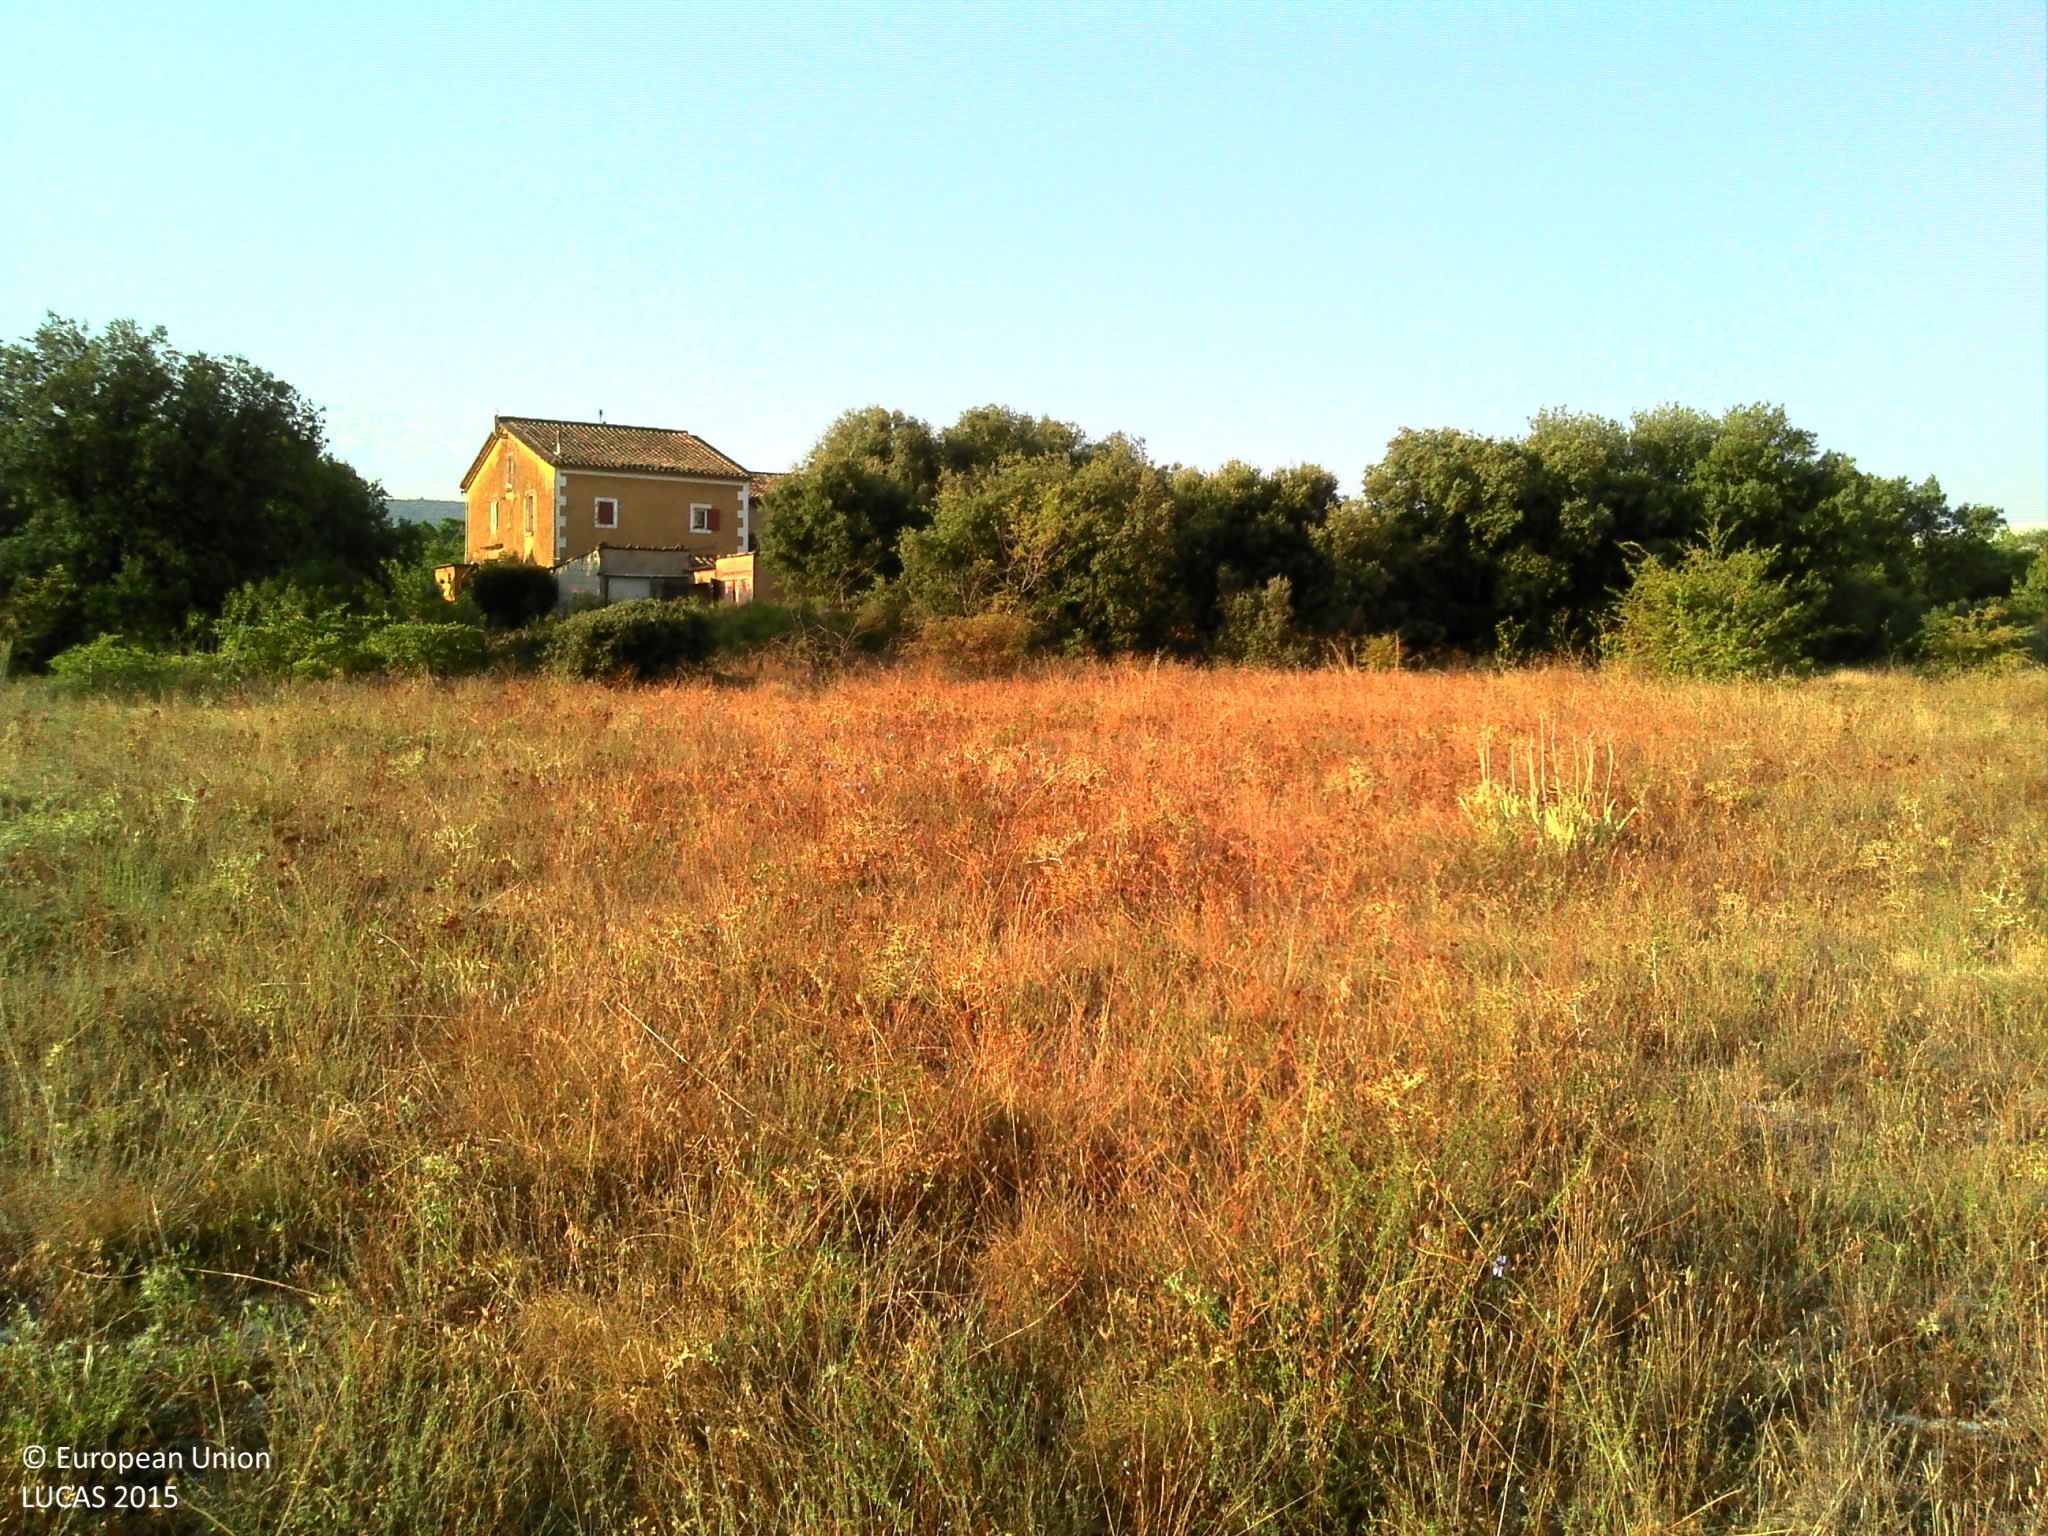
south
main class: Grassland
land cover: Spontaneously vegetated surfaces
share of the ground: > 75 %
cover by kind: herbaceous plants 80 %, unconsolidated bare surface 10 %, shrubs 5 %, lichens and mosses 5 %
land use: Semi-natural and natural areas not in use
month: August
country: FR
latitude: 43.8858
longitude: 5.3659
